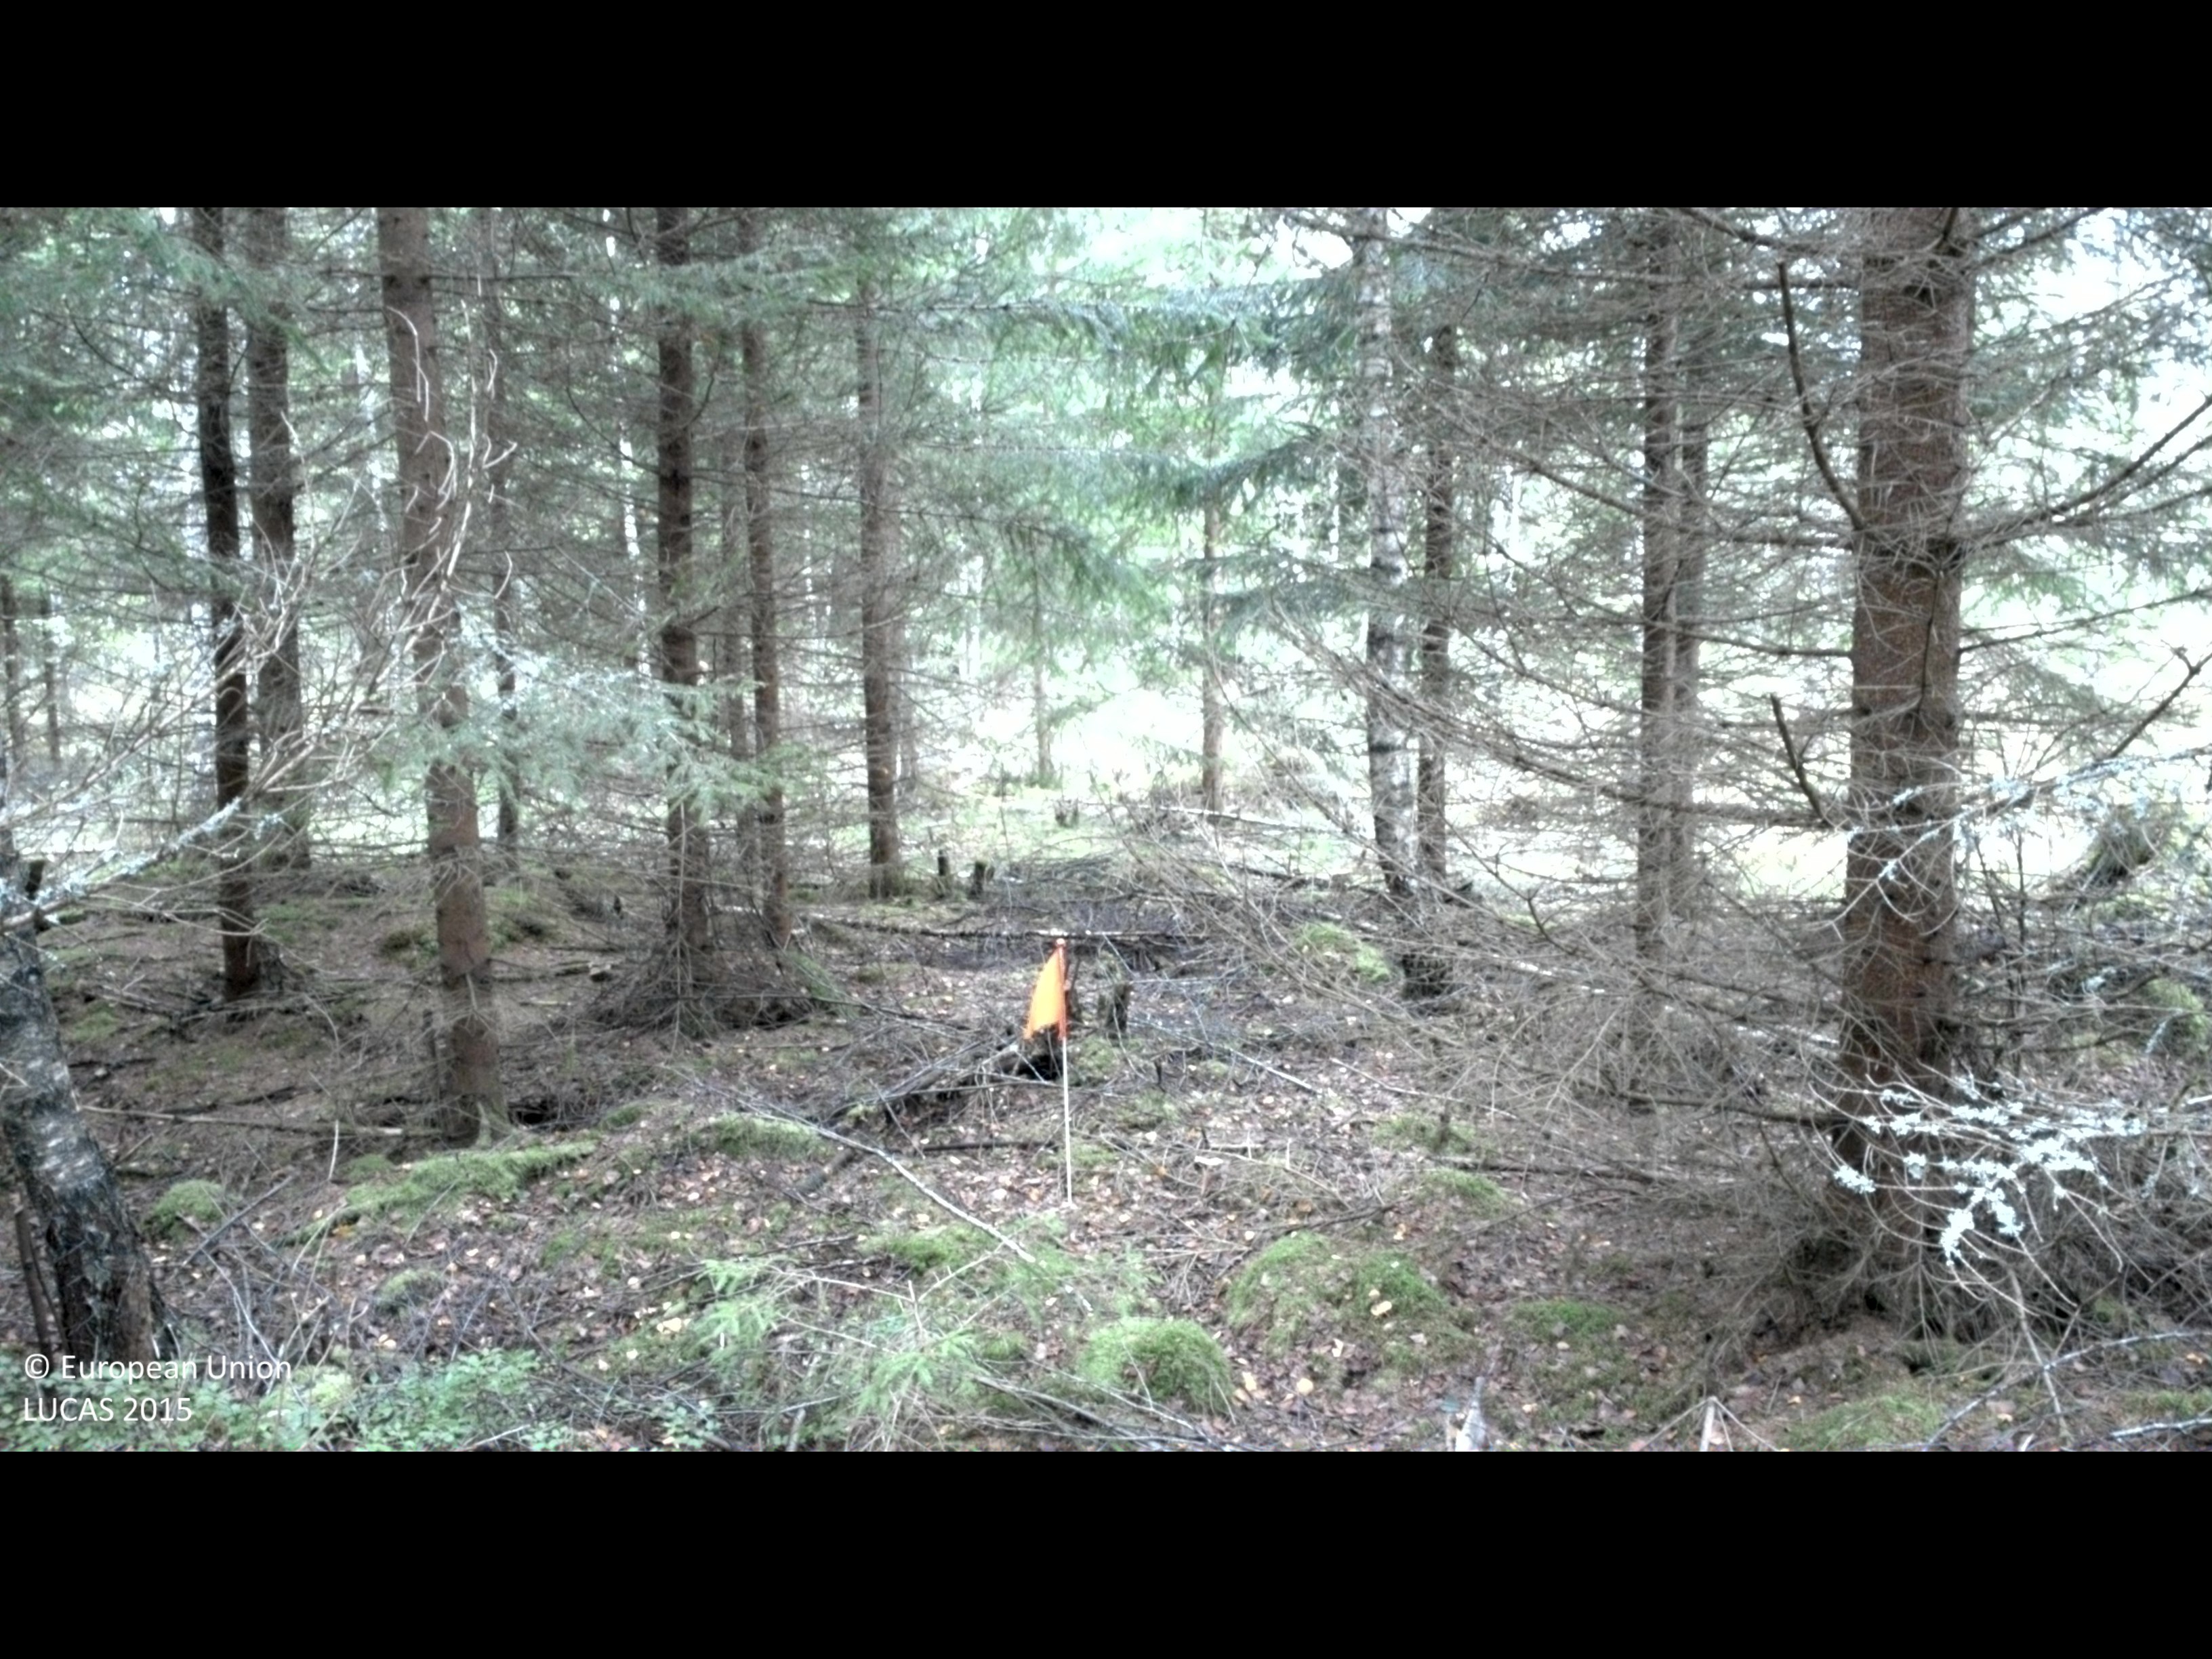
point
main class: Woodland
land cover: Spruce dominated coniferous woodland
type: boreal forest
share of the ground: > 75 %
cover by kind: coniferous forest trees 60 %, broadleaved forest trees 15 %, lichens and mosses 15 %, shrubs 10 %
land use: Forestry
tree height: > 5 m
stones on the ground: 25 - 50 %
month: July
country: SE
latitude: 56.8501
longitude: 13.8498
